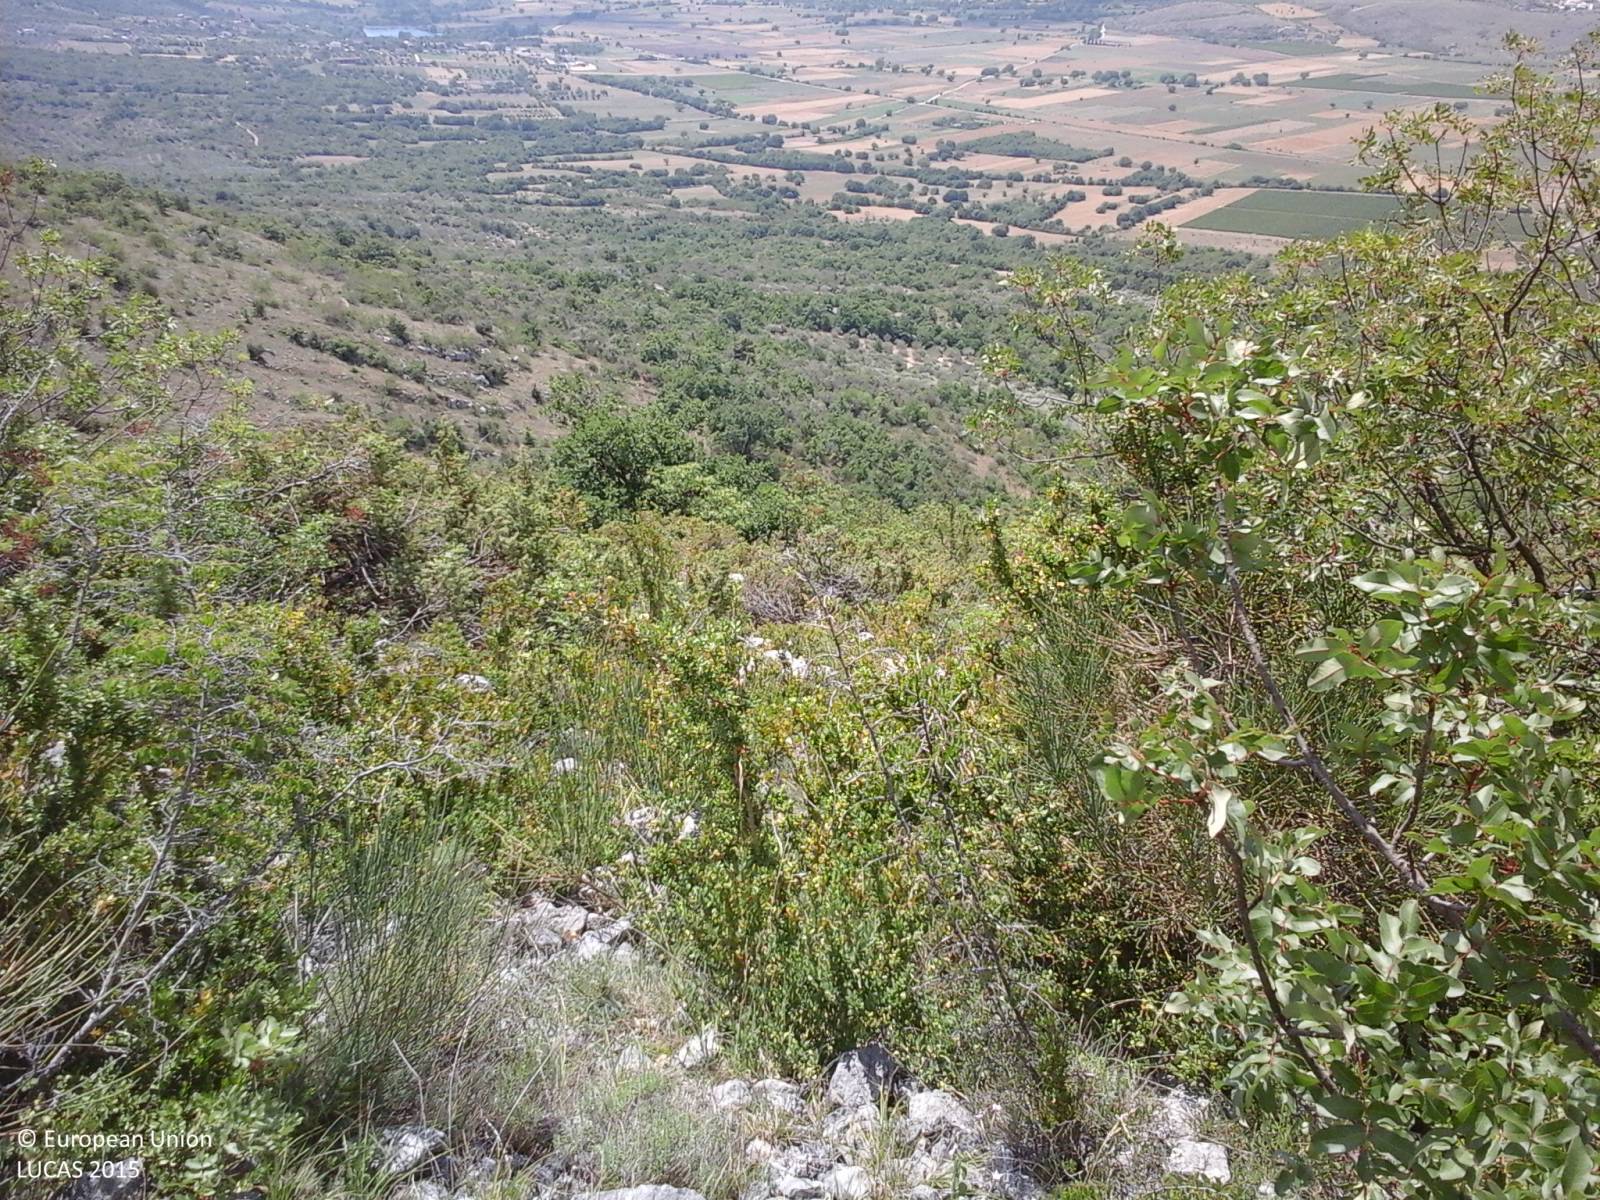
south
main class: Shrubland
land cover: Shrubland without tree cover
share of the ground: 50 - 75 %
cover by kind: shrubs 60 %, unconsolidated bare surface 35 %, herbaceous plants 5 %
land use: Semi-natural and natural areas not in use
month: June
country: IT
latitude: 42.3121
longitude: 13.7854
